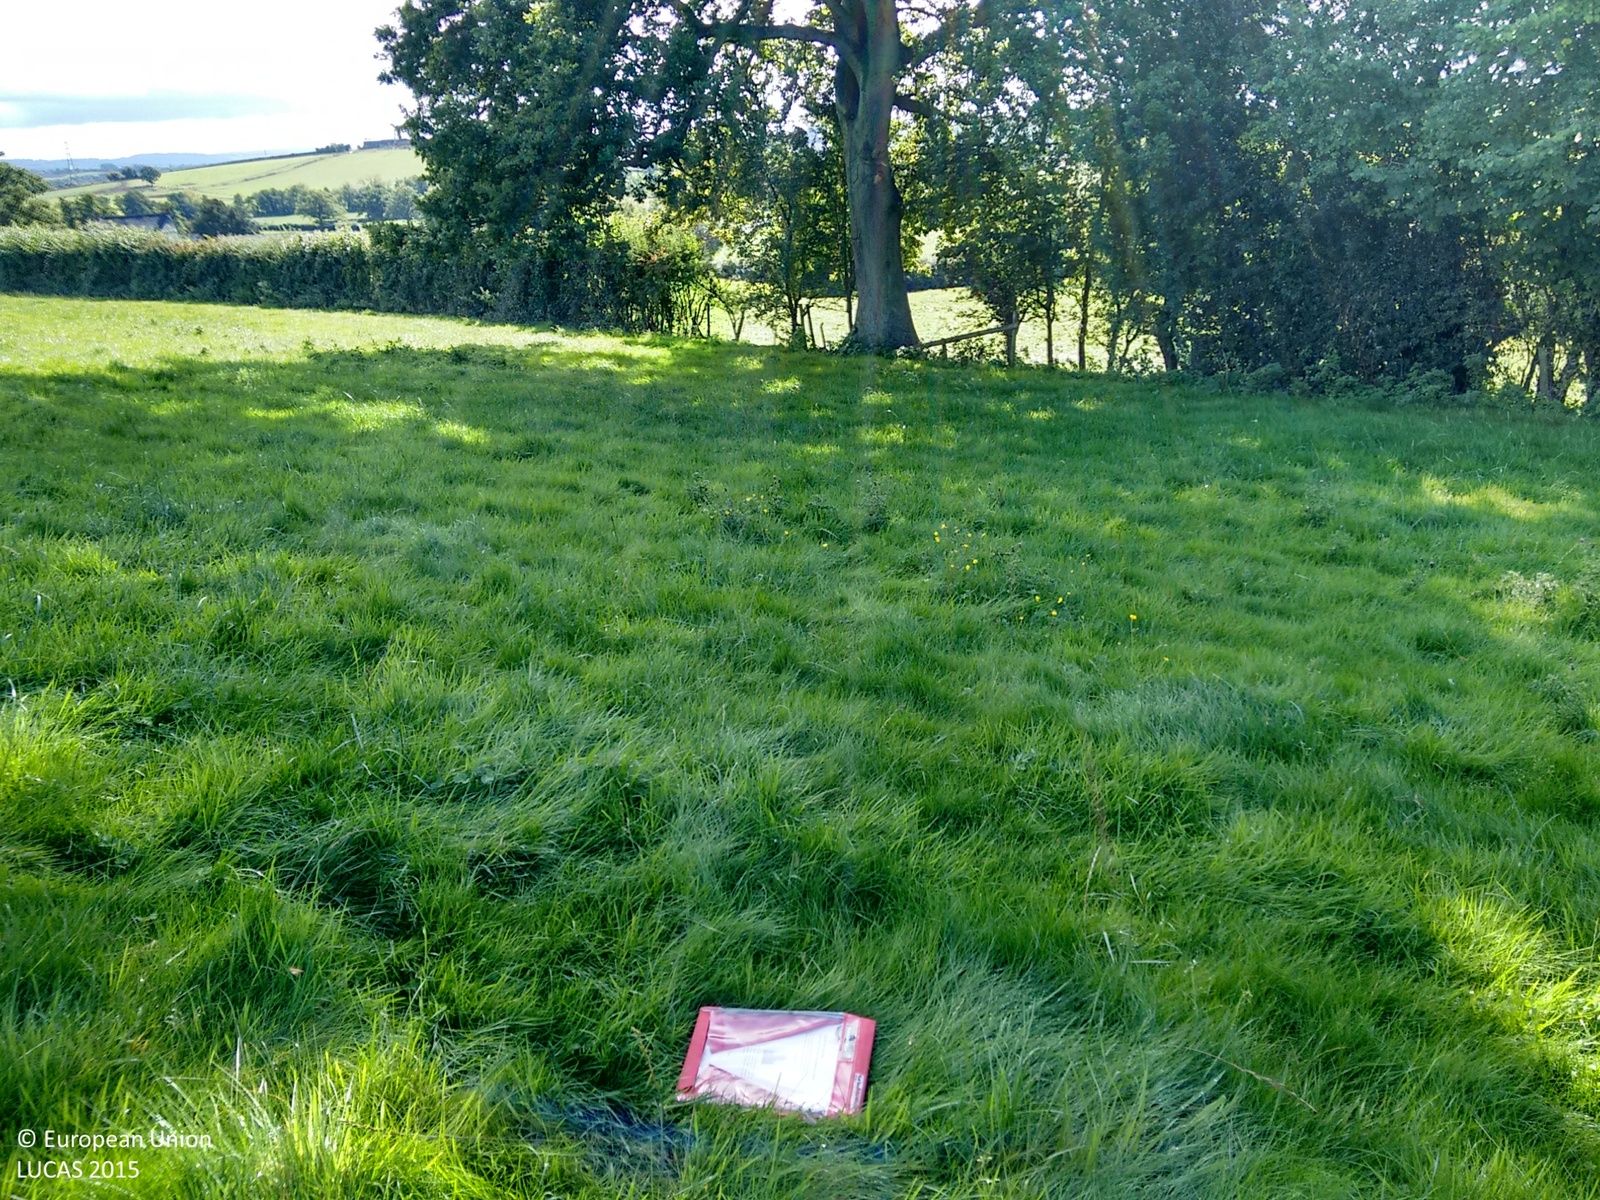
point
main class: Grassland
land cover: Grassland without tree/shrub cover
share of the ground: > 75 %
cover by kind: herbaceous plants 100 %
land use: Agriculture (excluding fallow land and kitchen gardens)
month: September
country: GB
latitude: 51.8320
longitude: -2.9163
